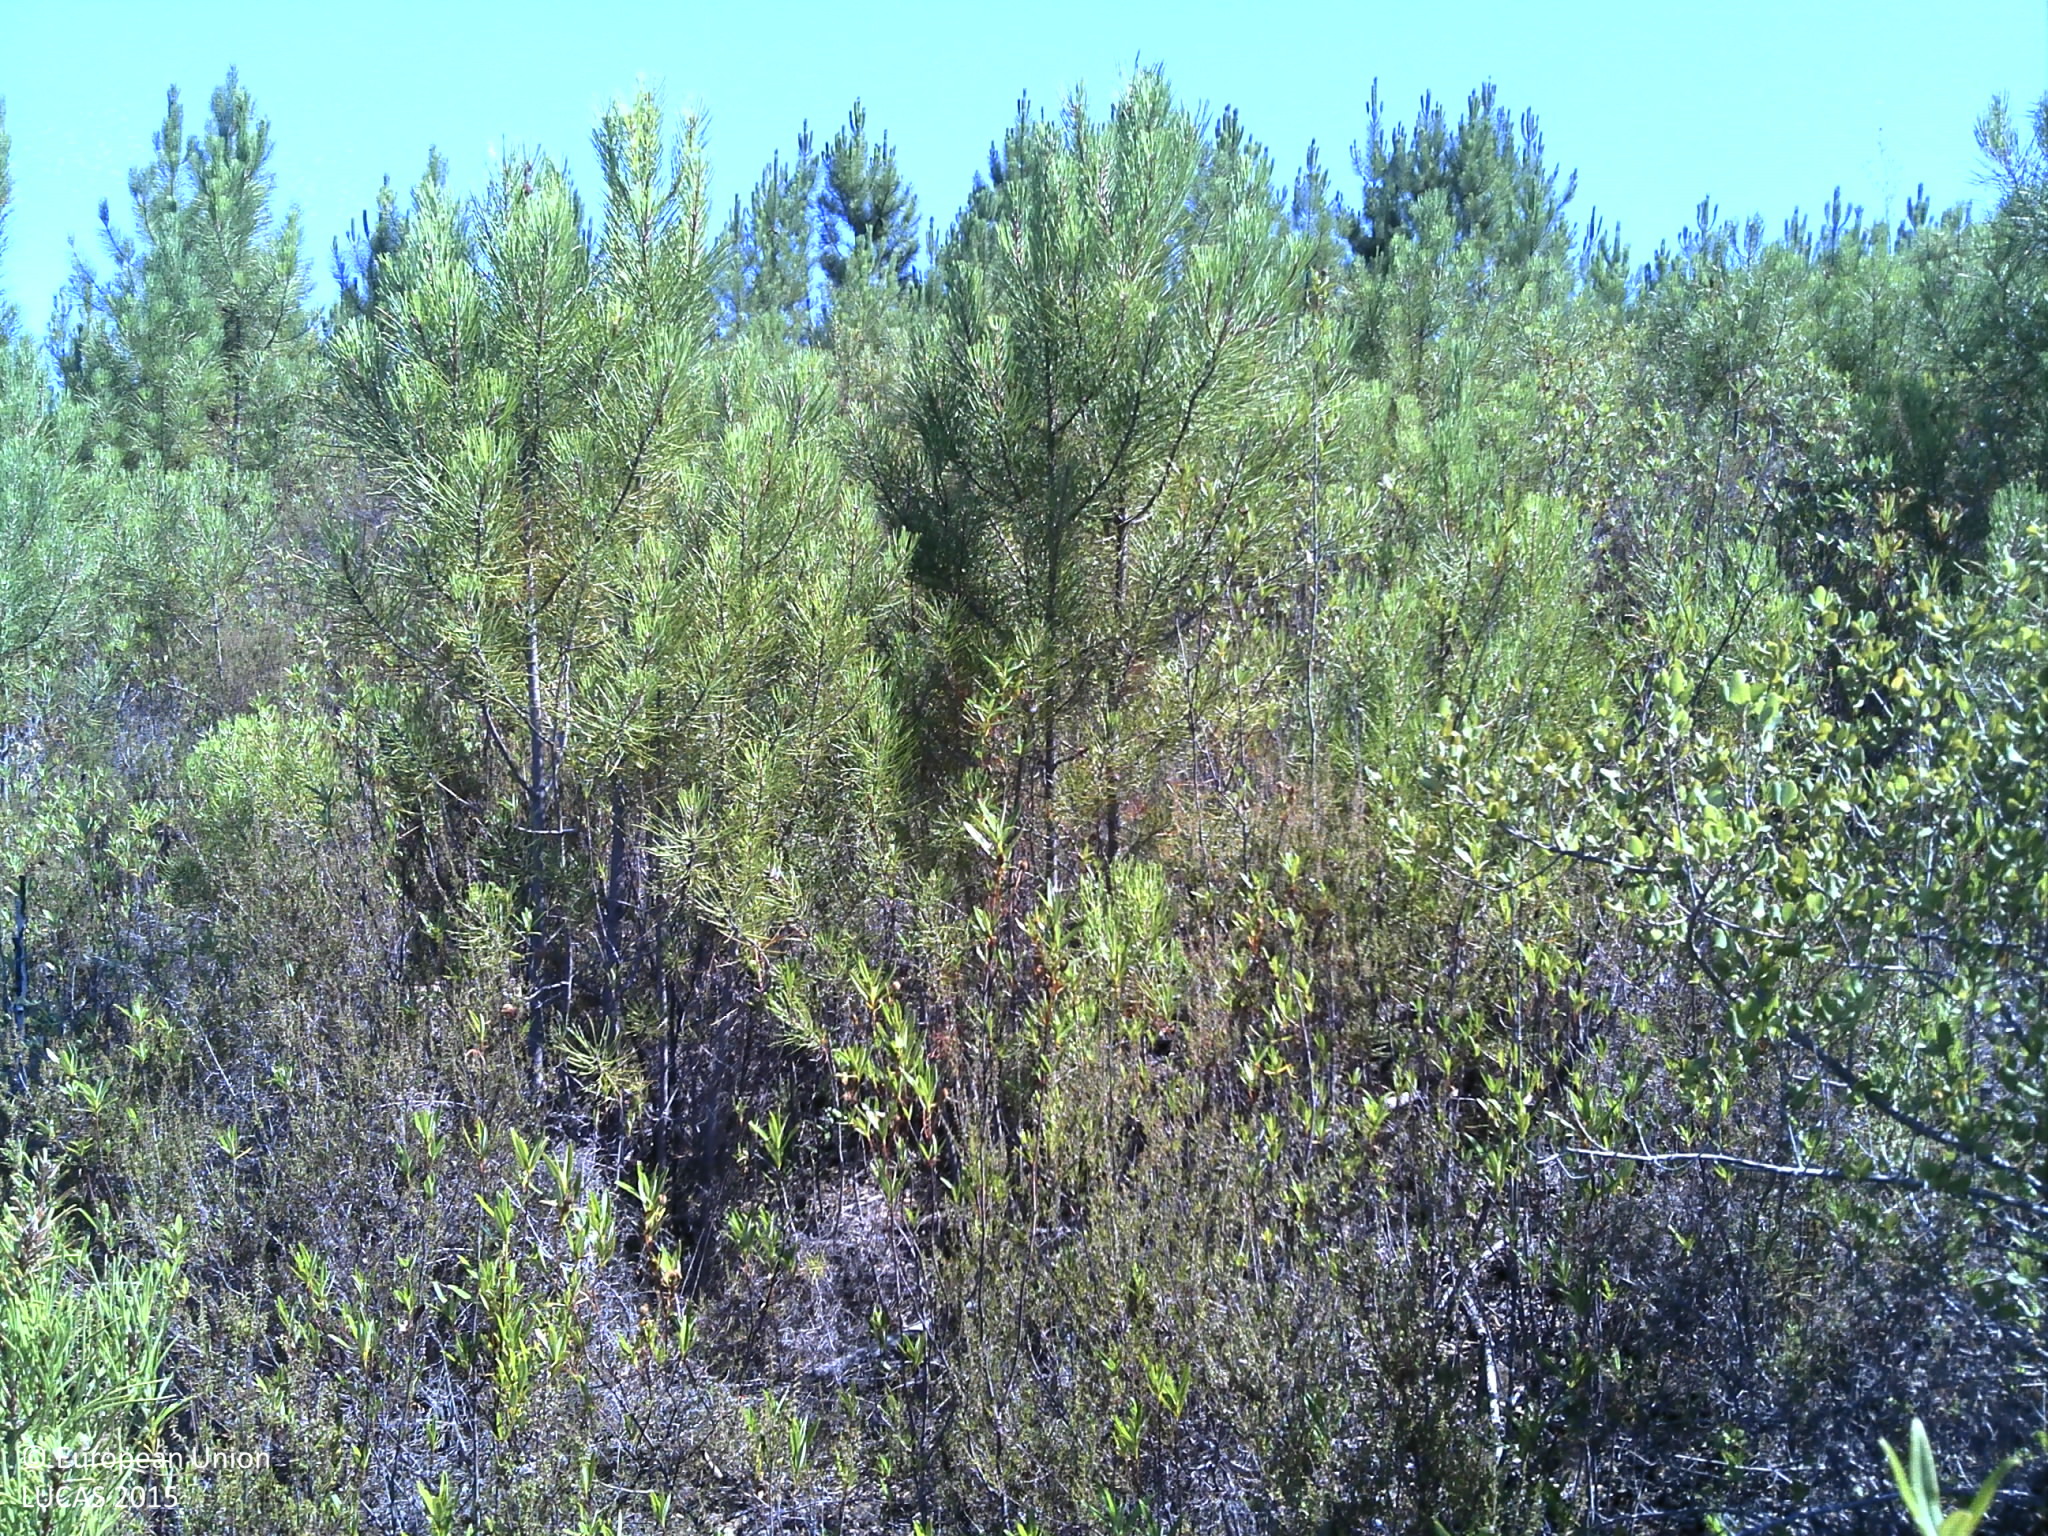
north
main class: Woodland
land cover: Pine dominated coniferous woodland
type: coniferous forest of the mediterranean region
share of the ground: < 10 %
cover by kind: shrubs 85 %, coniferous forest trees 15 %
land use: Forestry
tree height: < 5 m
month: July
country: PT
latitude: 39.7162
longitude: -8.0881
